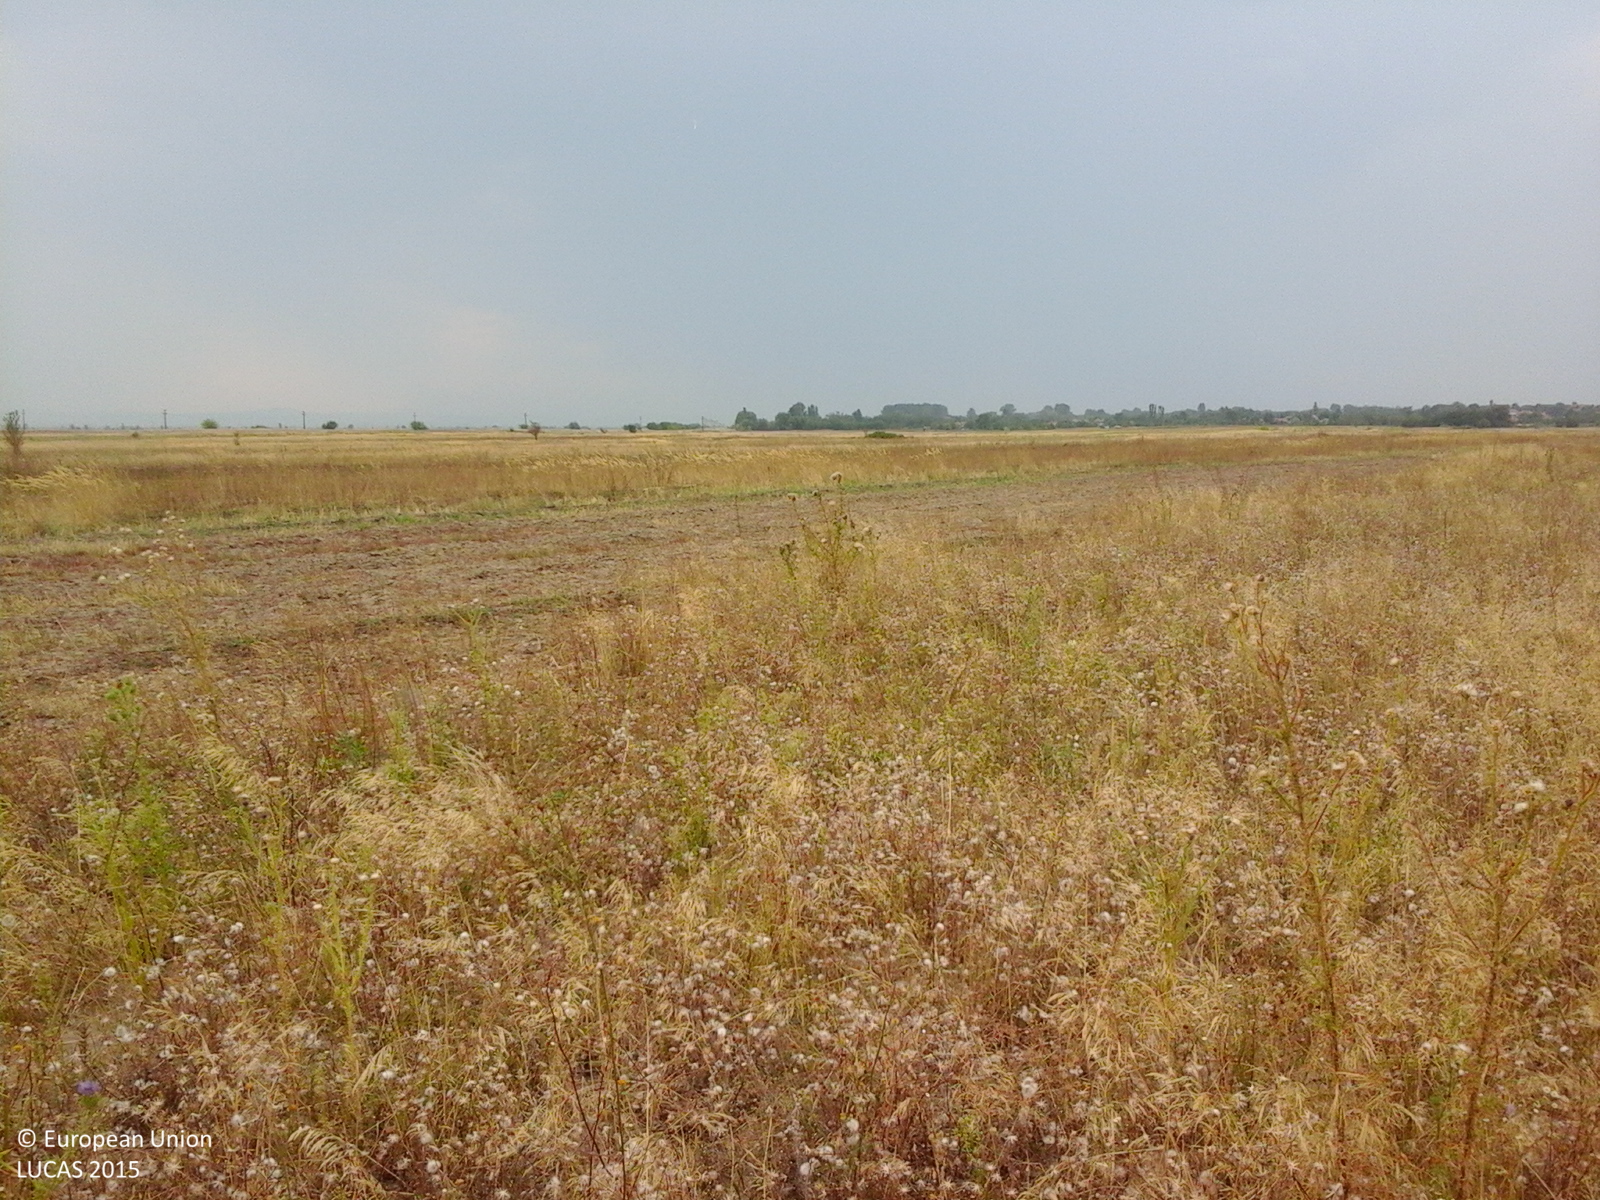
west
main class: Grassland
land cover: Spontaneously vegetated surfaces
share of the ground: > 75 %
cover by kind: herbaceous plants 100 %
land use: Fallow land
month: August
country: RO
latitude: 44.4546
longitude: 22.7469
